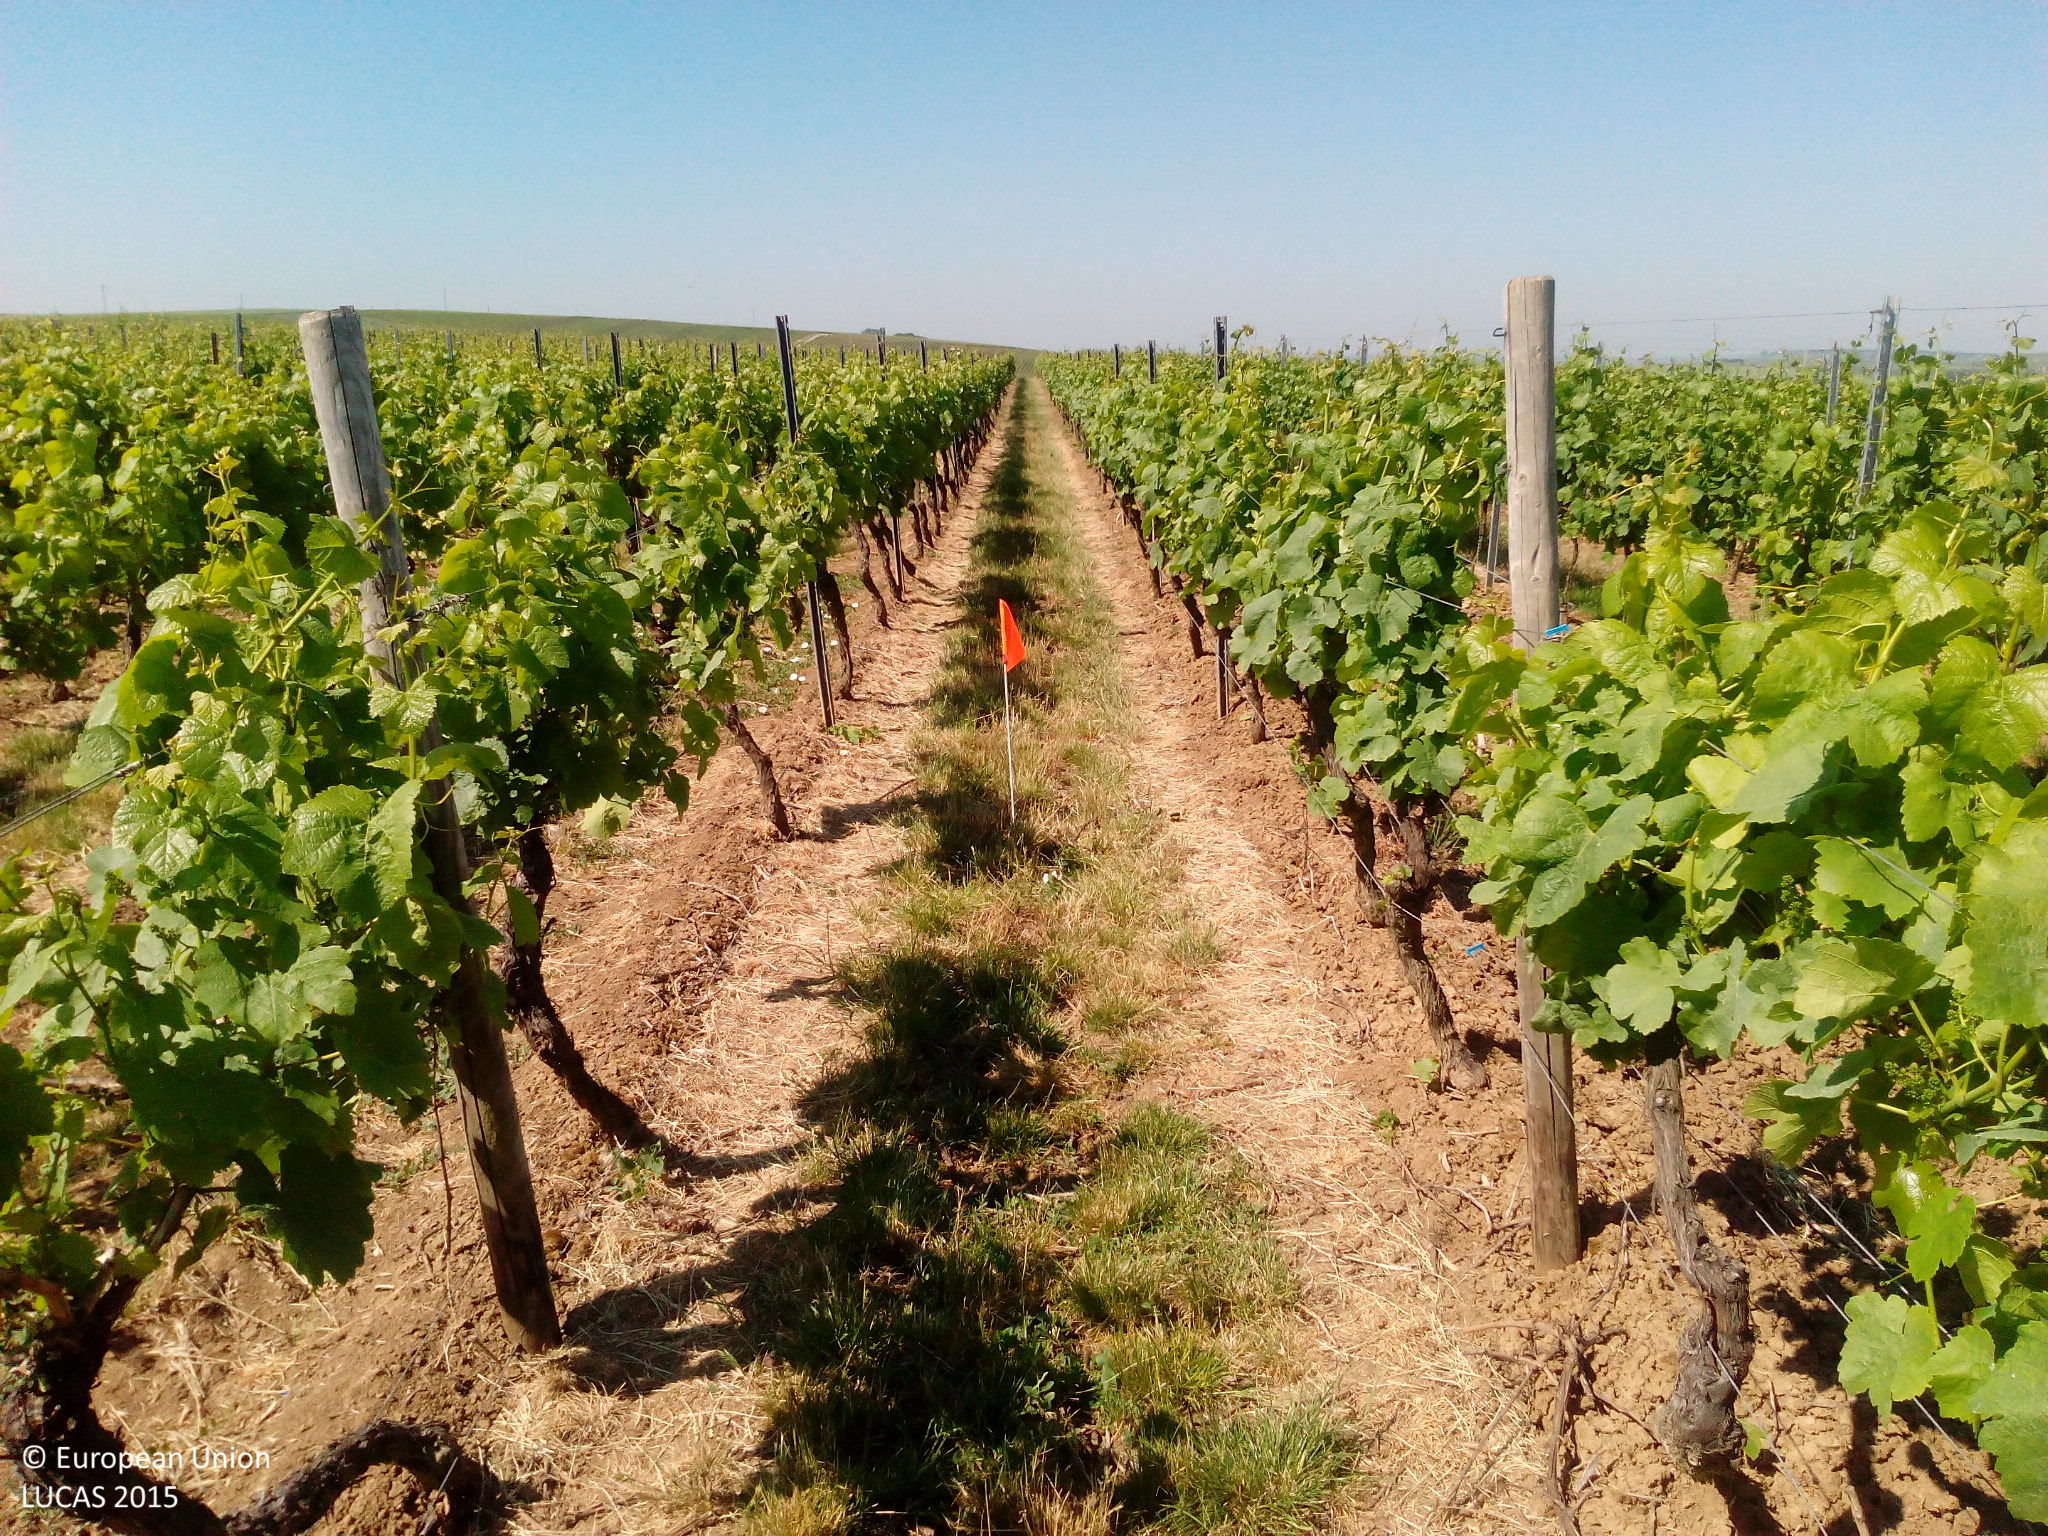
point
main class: Cropland
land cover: Vineyards
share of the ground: 50 - 75 %
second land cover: Grassland without tree/shrub cover
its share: 50 - 75 %
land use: Agriculture (excluding fallow land and kitchen gardens)
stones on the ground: < 10 %
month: June
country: DE
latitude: 49.8635
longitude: 8.1502
